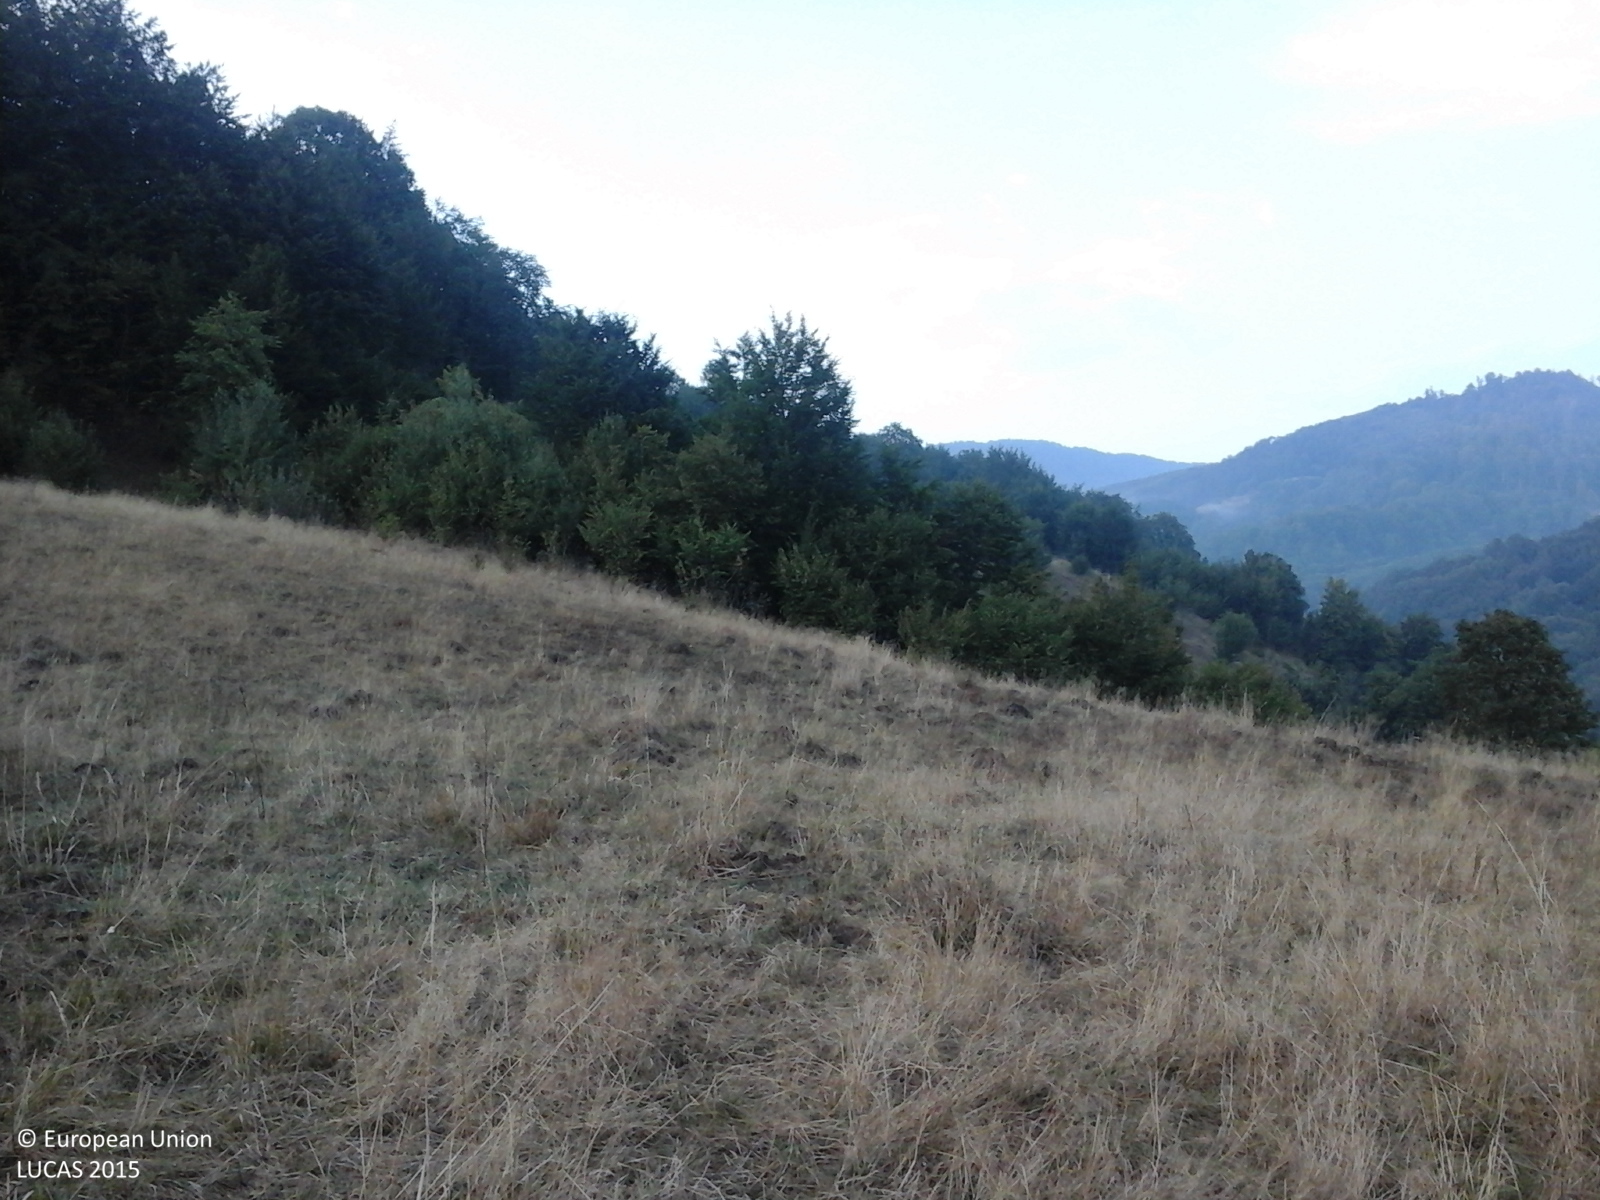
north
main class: Grassland
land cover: Grassland without tree/shrub cover
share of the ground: > 75 %
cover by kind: herbaceous plants 100 %
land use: Agriculture (excluding fallow land and kitchen gardens)
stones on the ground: < 10 %
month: September
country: RO
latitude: 47.5730
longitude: 24.0564
